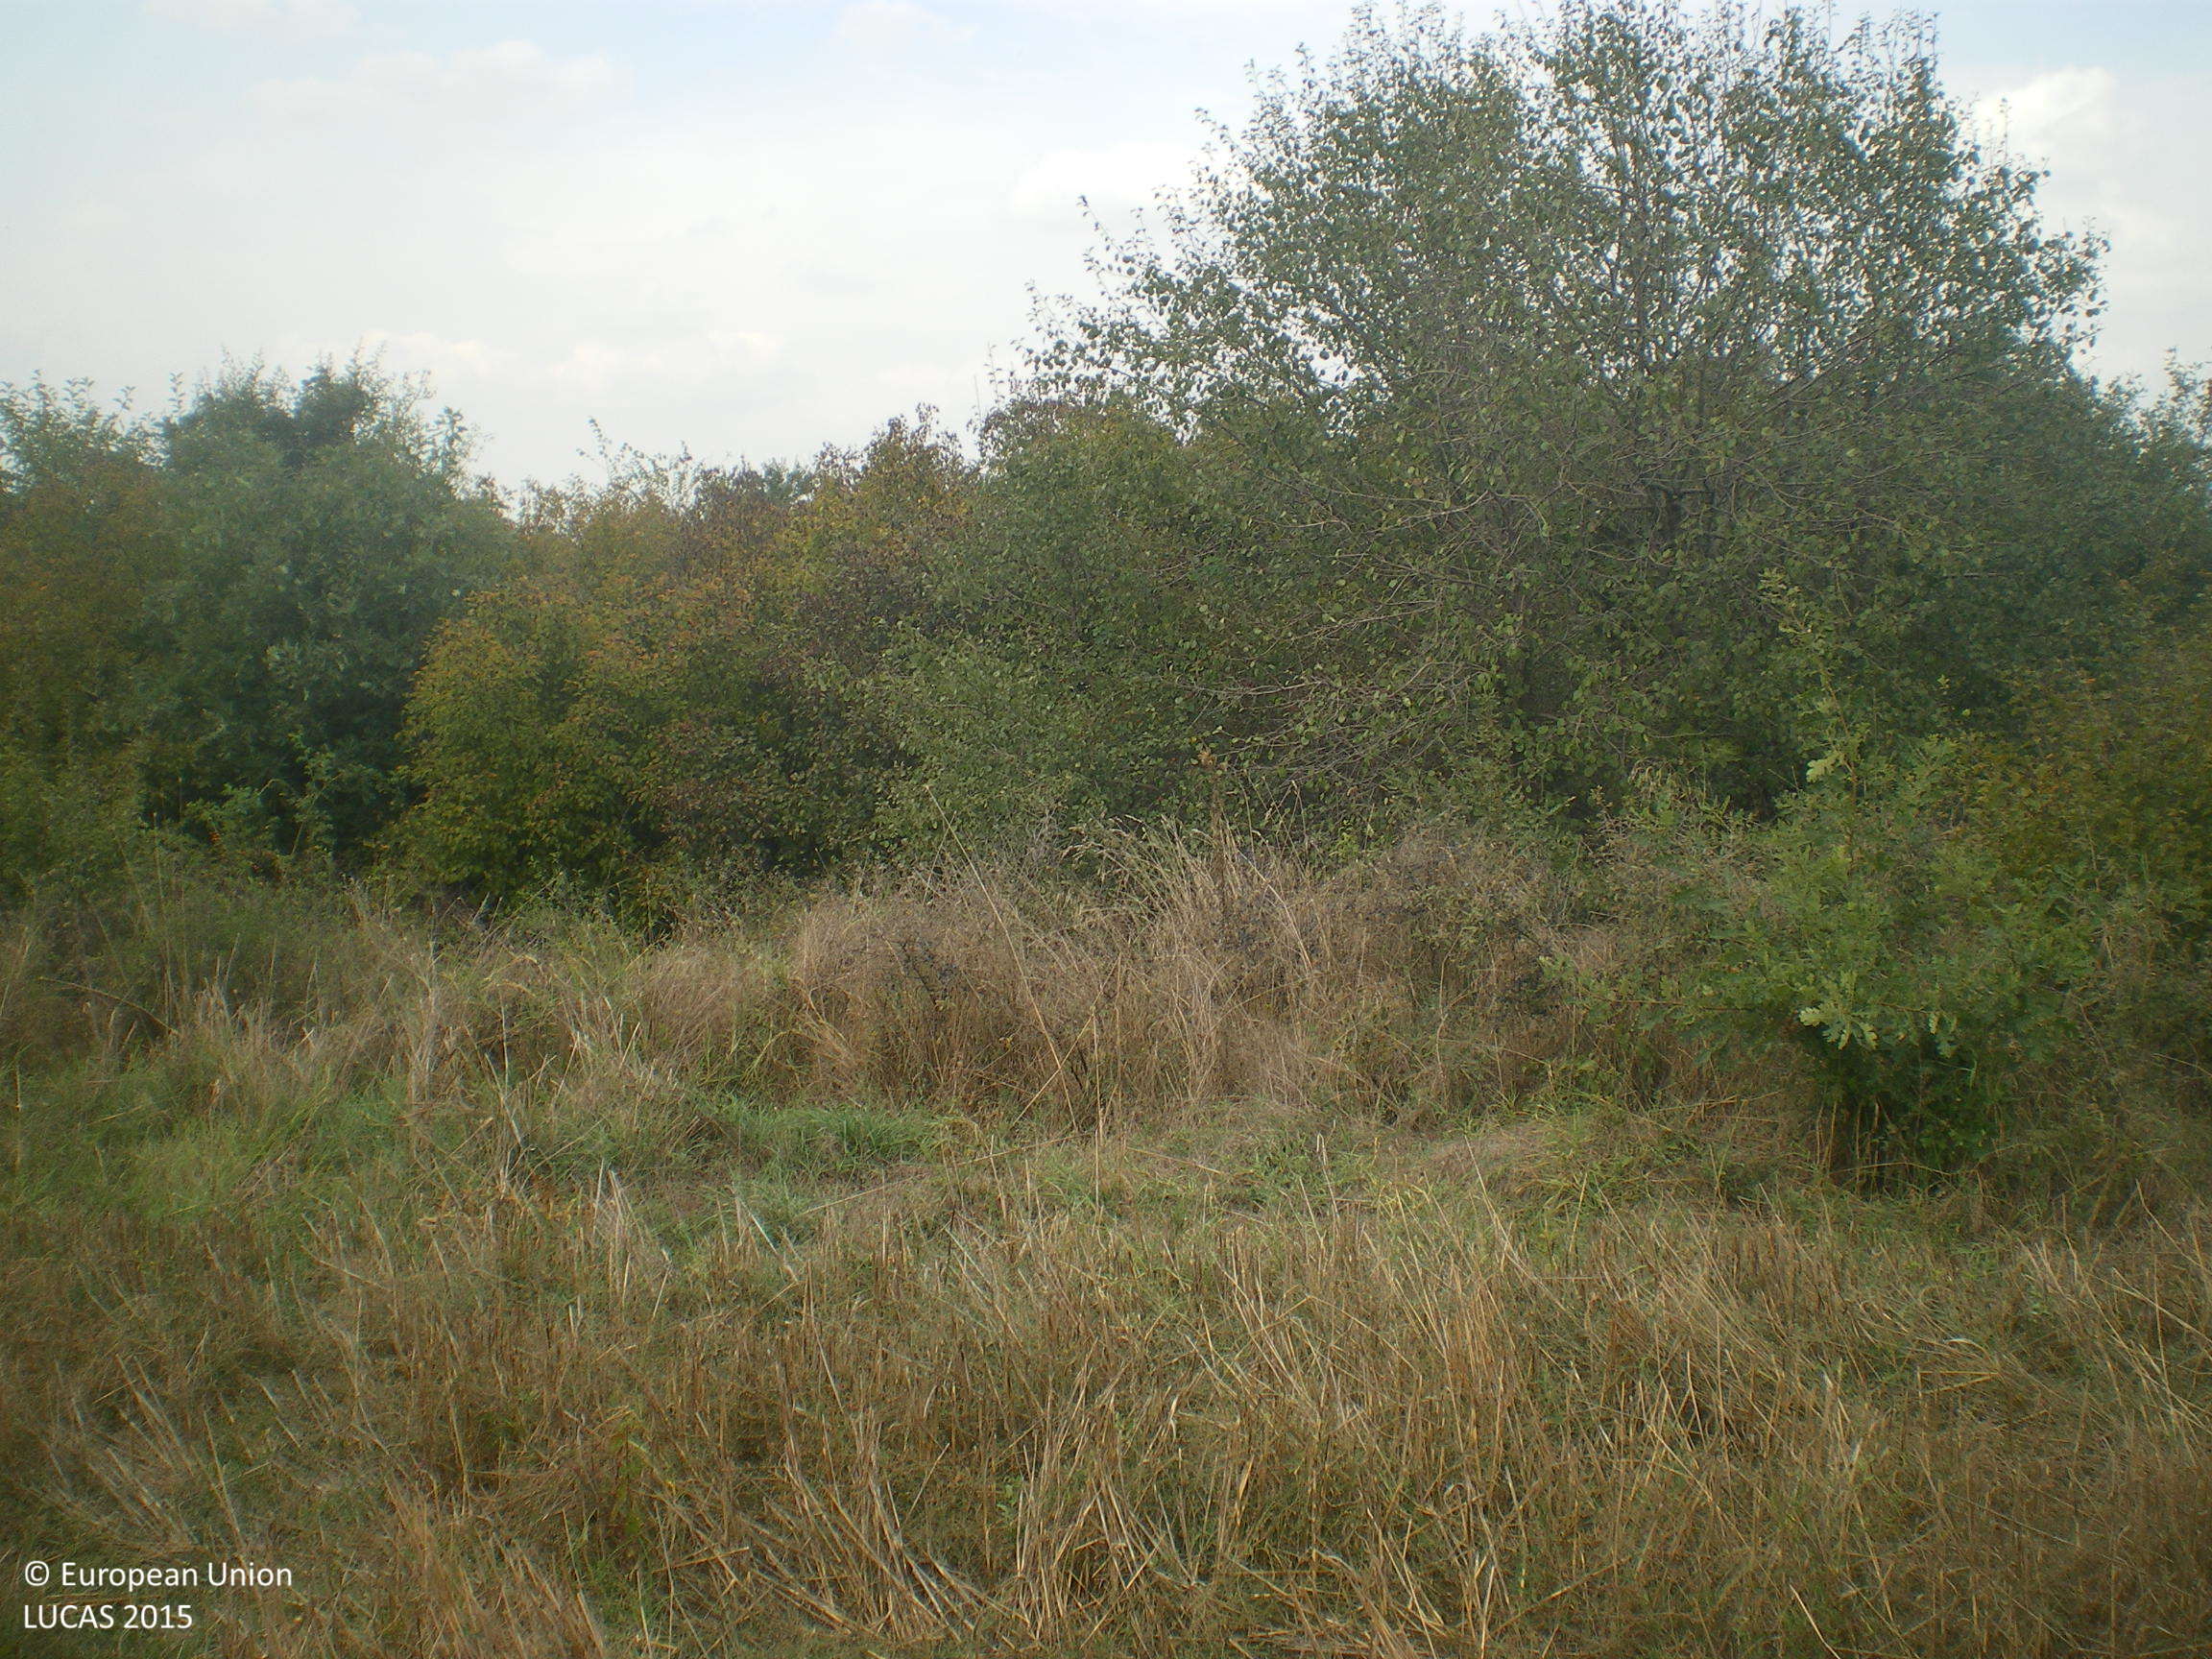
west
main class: Cropland
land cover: Common wheat
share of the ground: 10 - 25 %
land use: Agriculture (excluding fallow land and kitchen gardens)
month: September
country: BG
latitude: 42.0404
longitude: 25.9599
